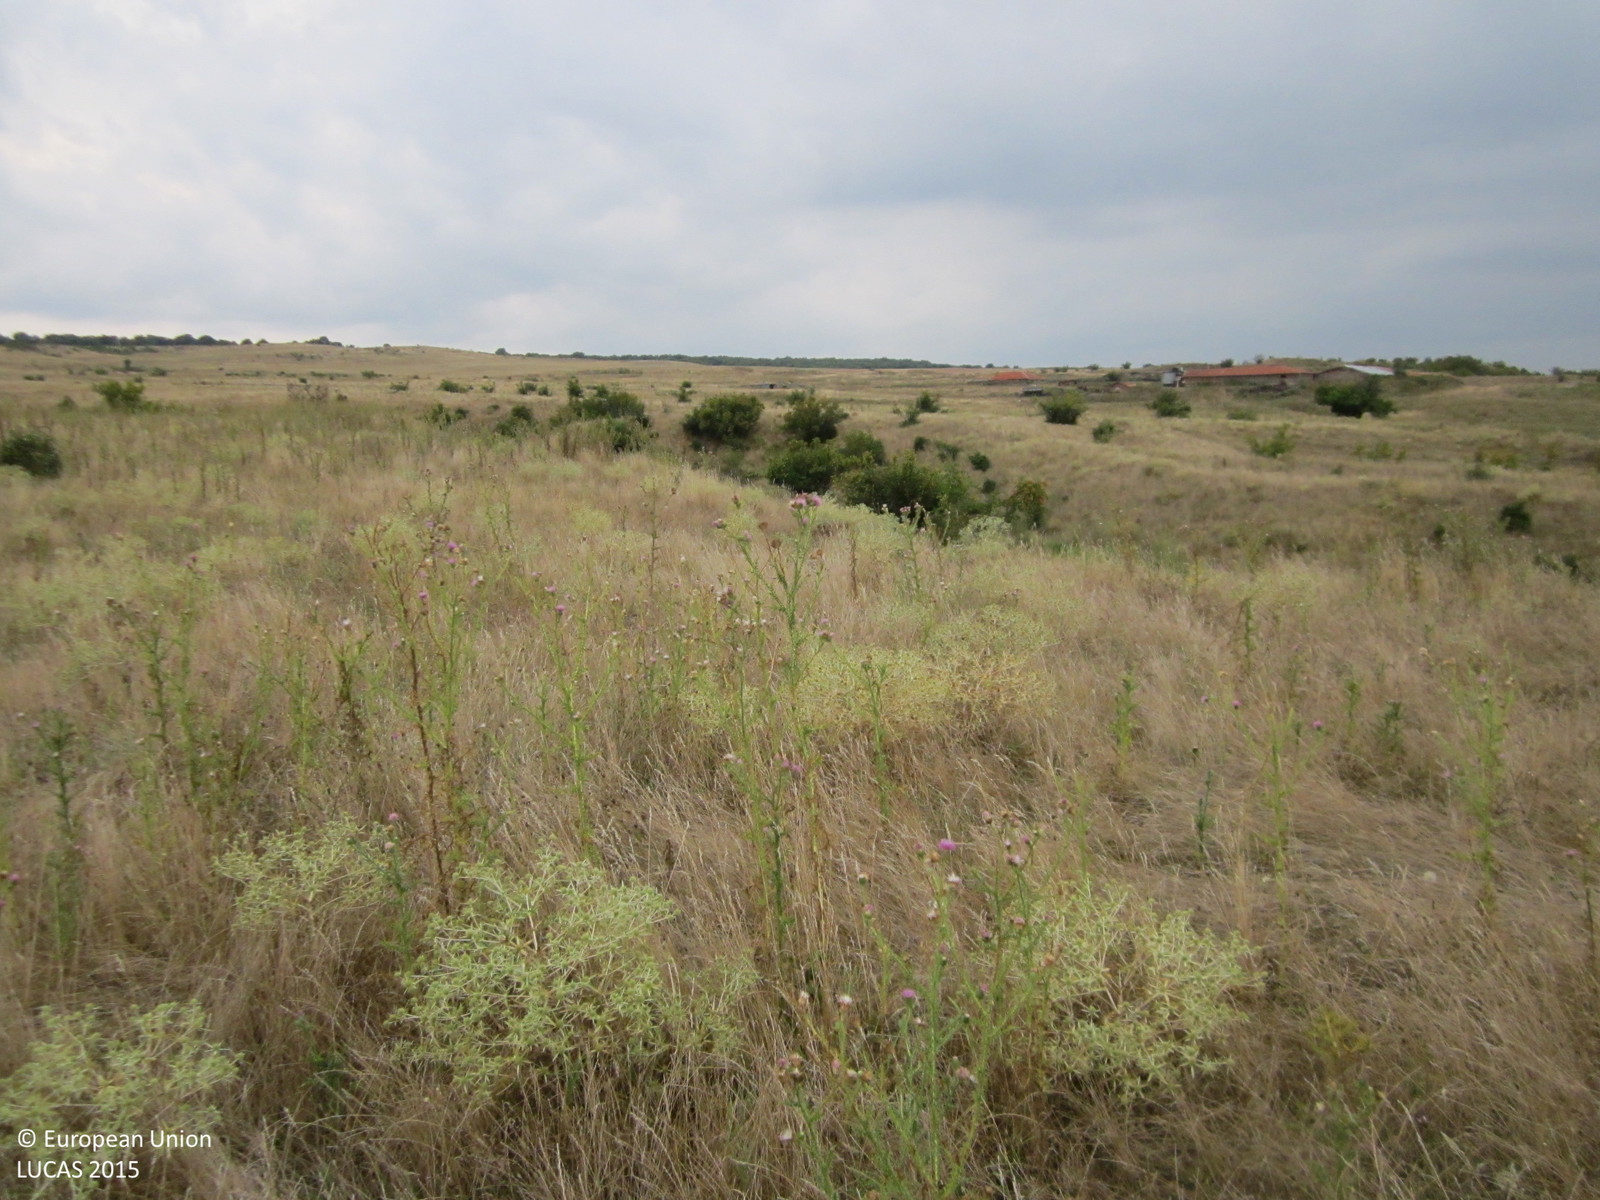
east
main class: Grassland
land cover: Grassland without tree/shrub cover
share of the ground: > 75 %
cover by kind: herbaceous plants 95 %, shrubs 5 %
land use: Agriculture (excluding fallow land and kitchen gardens)
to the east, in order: Grassland without tree/shrub cover; Tracks; Grassland with sparse tree/shrub cover; Broadleaved woodland; Rivers and streams; Broadleaved woodland; Tracks; Grass margins; Other bare soil; Grassland with sparse tree/shrub cover
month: August
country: BG
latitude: 42.4967
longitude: 26.9810
